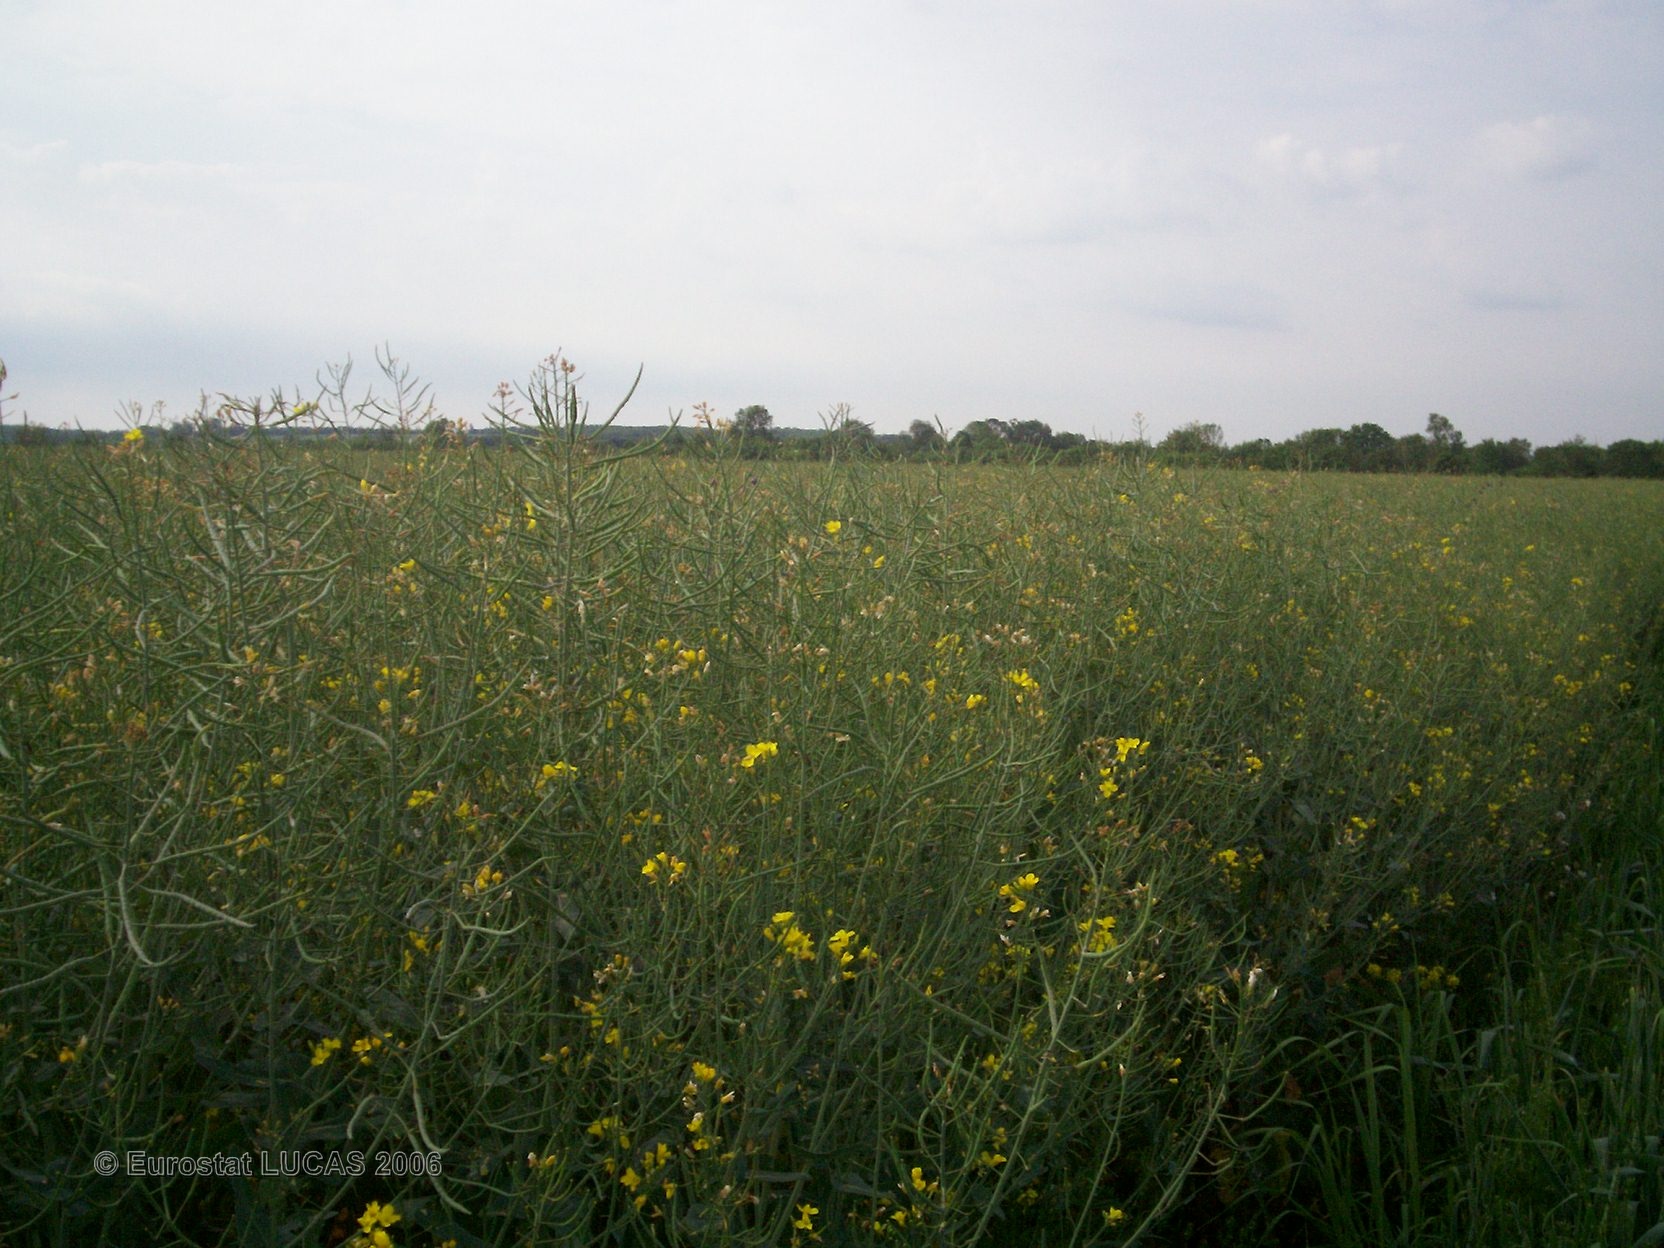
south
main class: Cropland
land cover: Rape and turnip rape
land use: Agriculture (excluding fallow land and kitchen gardens)
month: May
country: FR
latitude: 46.1135
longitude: -0.2309
